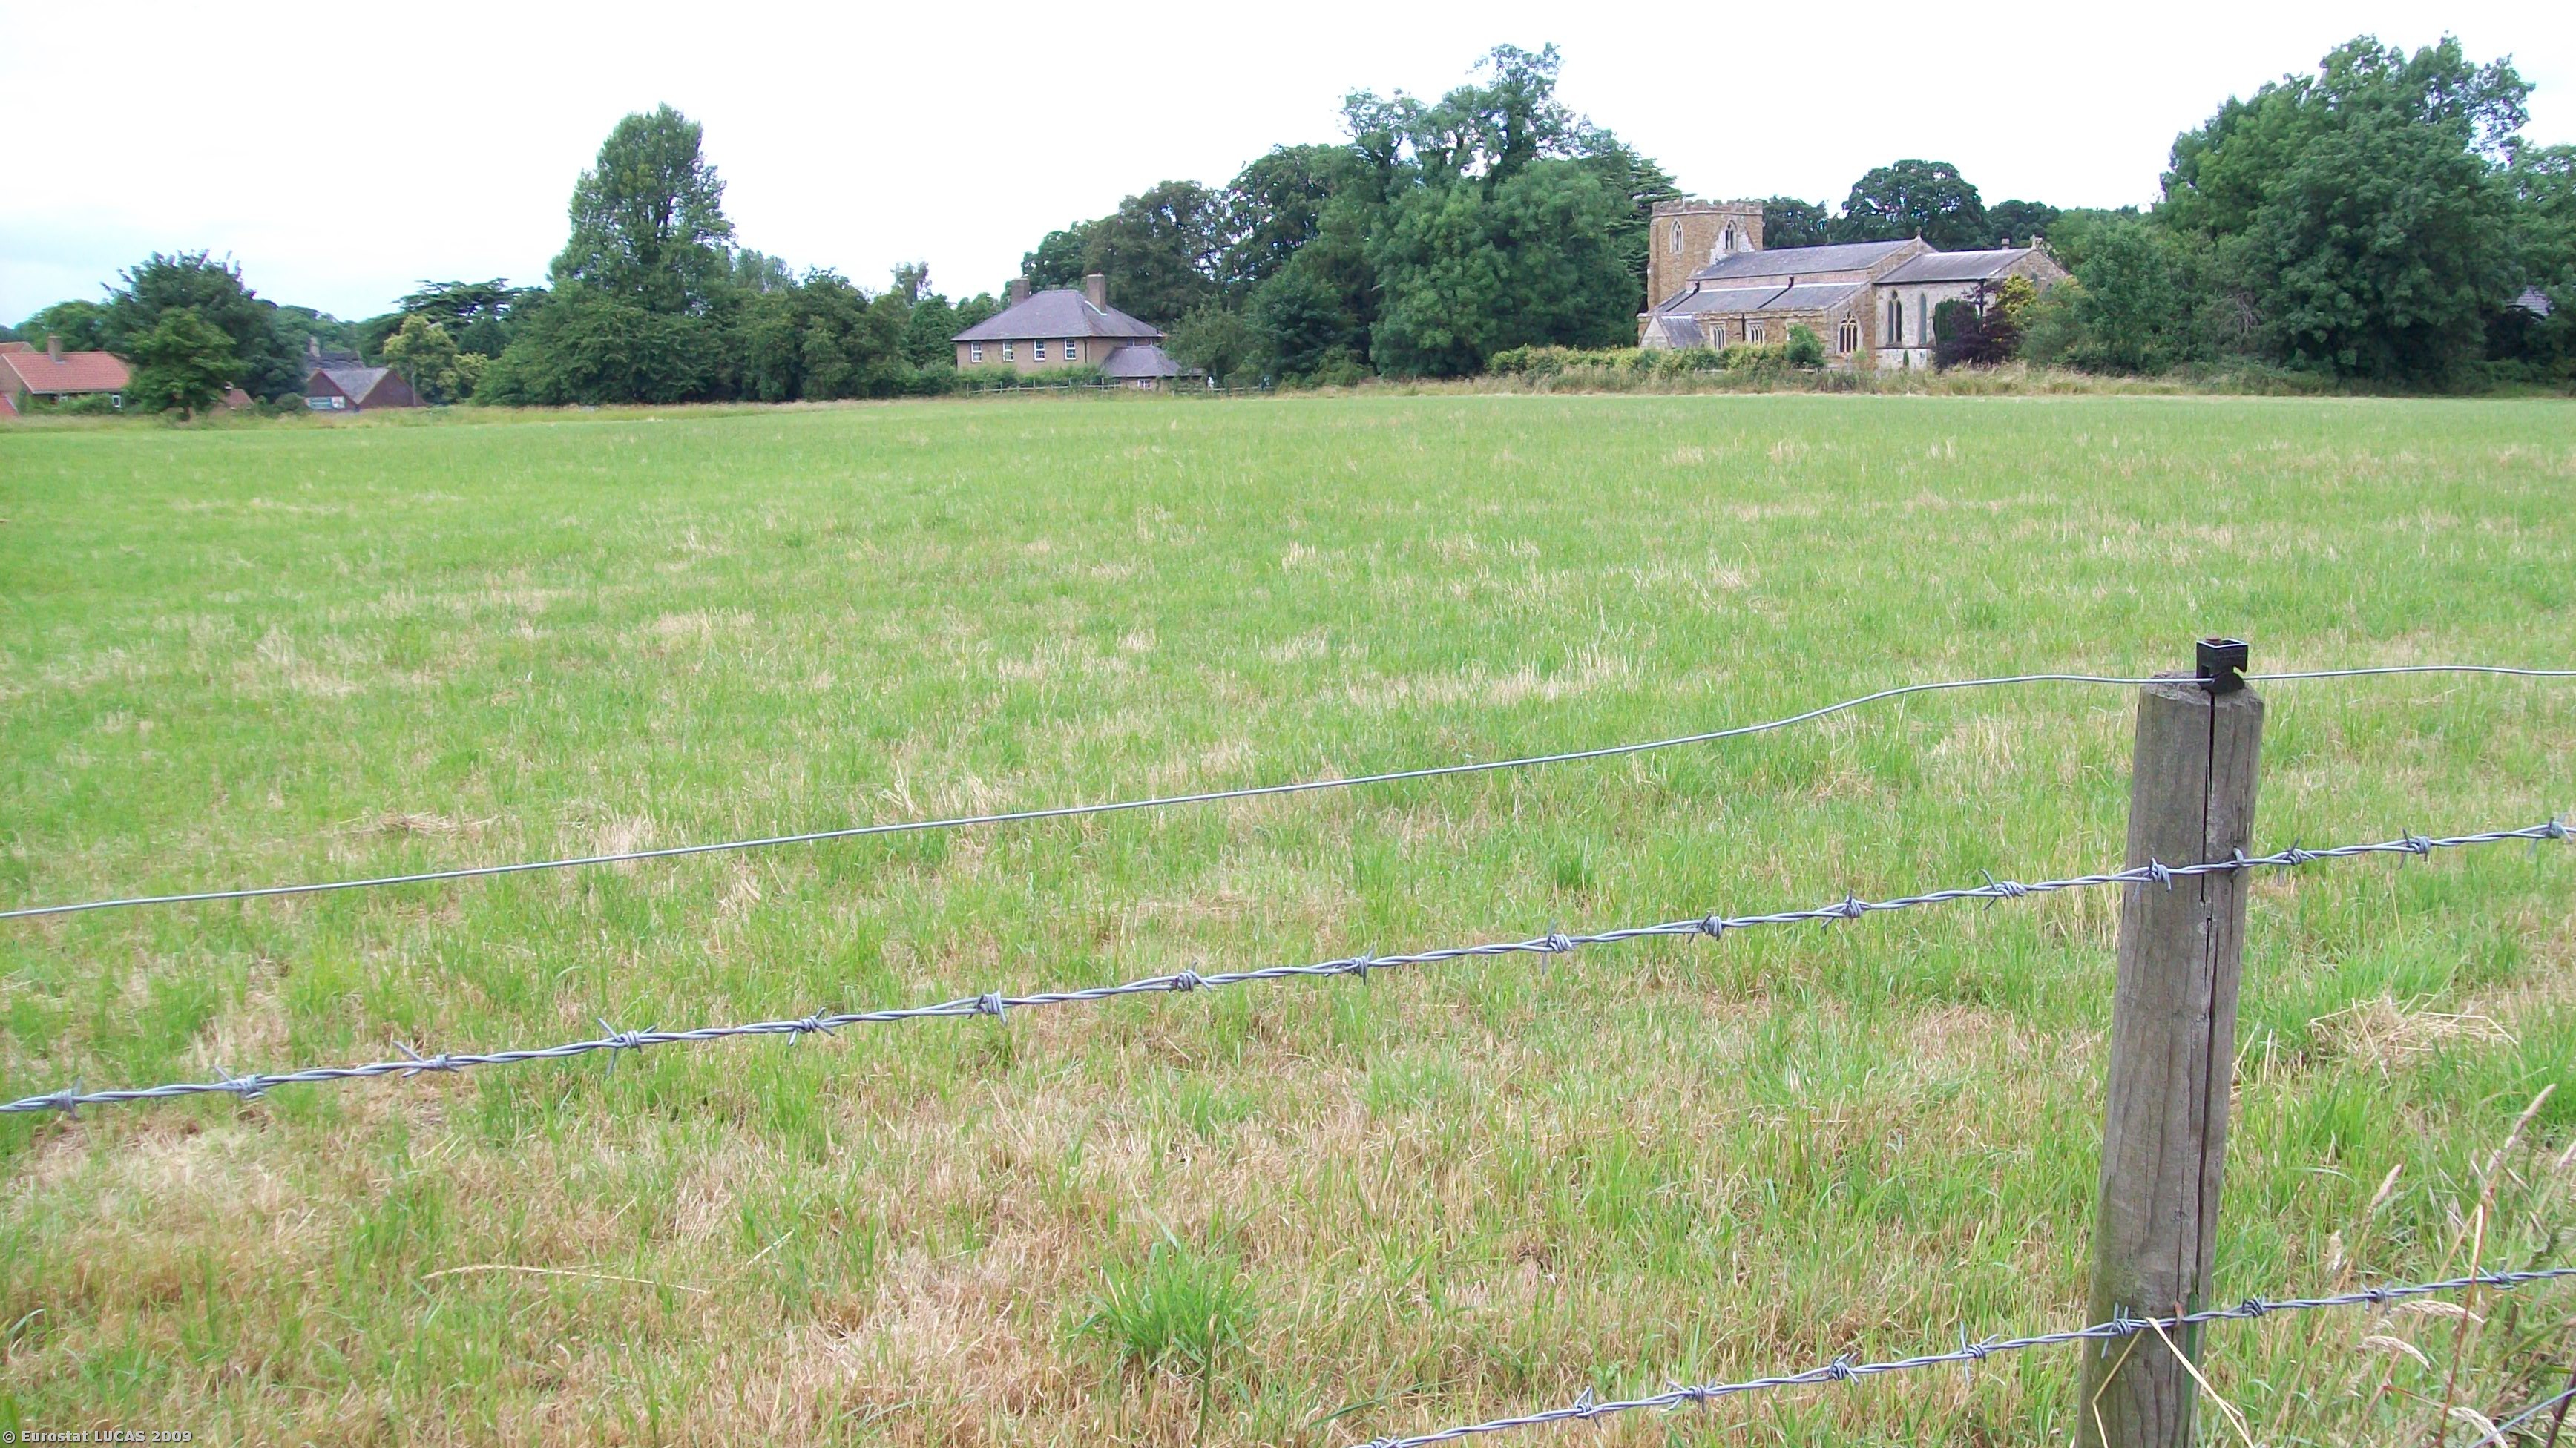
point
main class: Cropland
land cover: Temporary grasslands
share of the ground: > 75 %
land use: Agriculture (excluding fallow land and kitchen gardens)
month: July
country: GB
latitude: 53.5611
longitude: -0.2857
